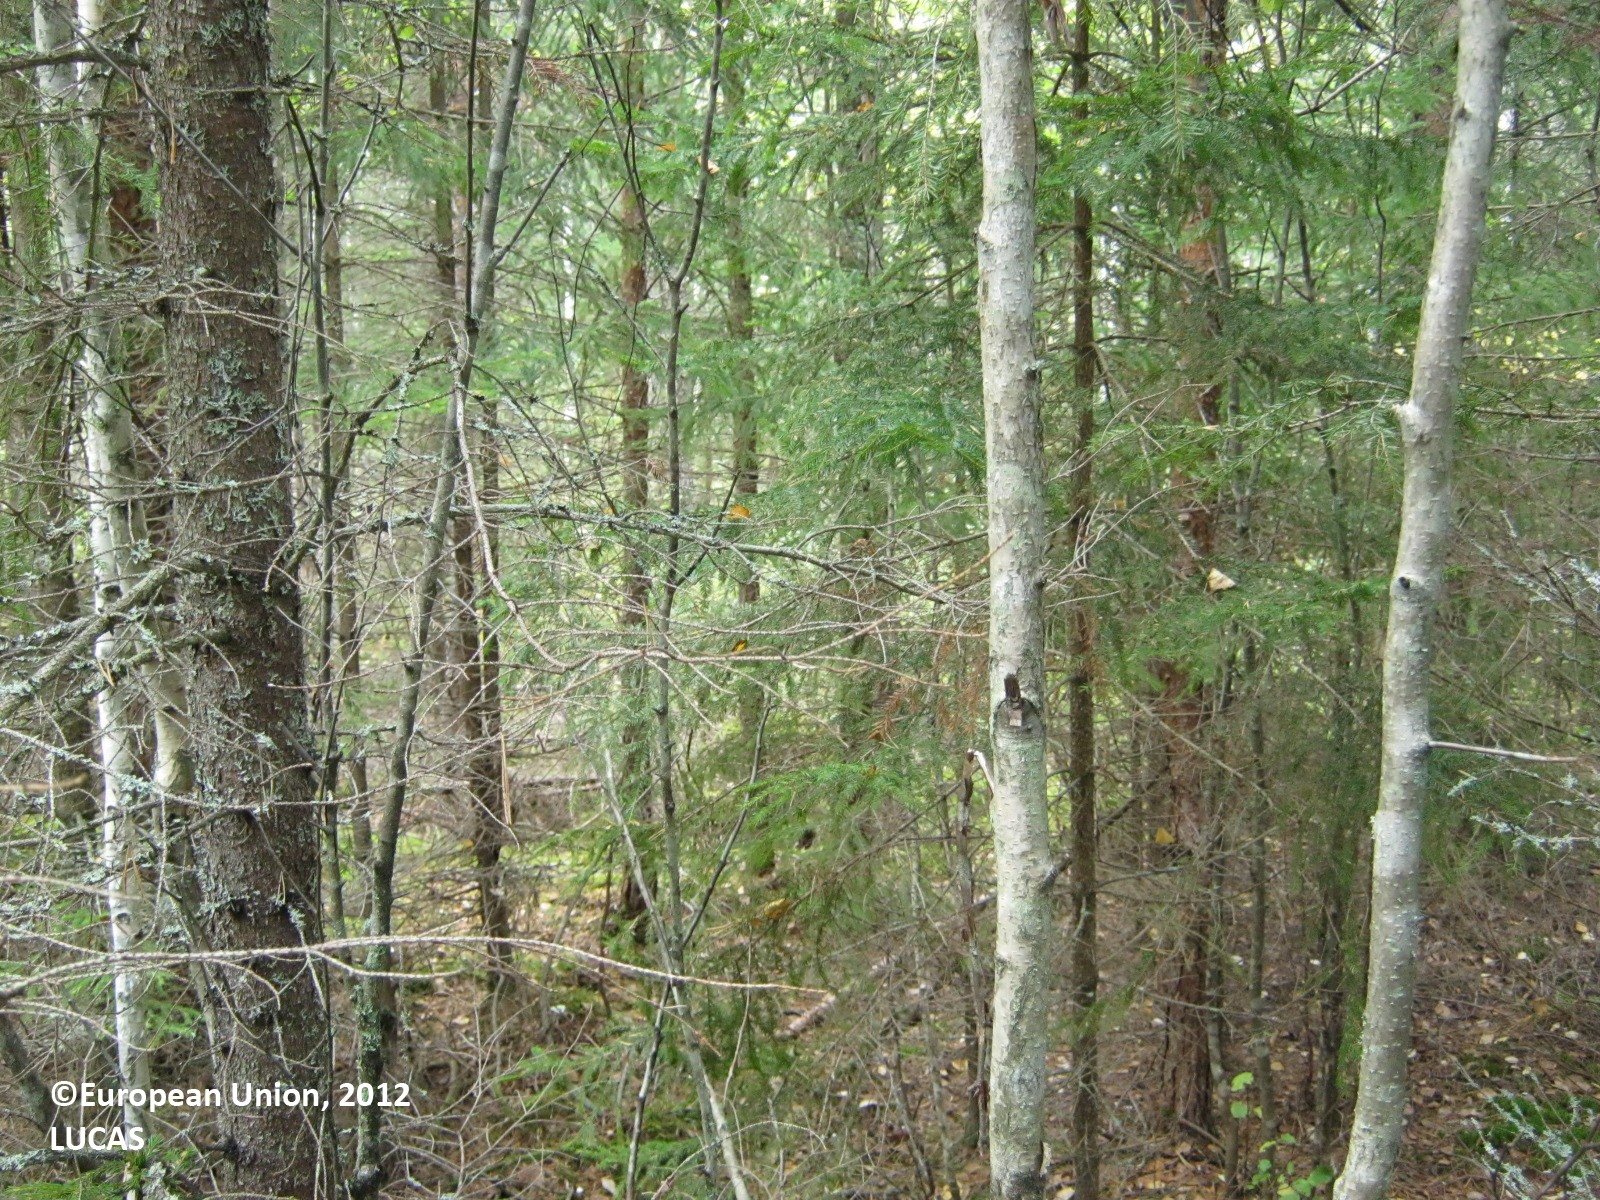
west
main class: Woodland
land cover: Other coniferous woodland
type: boreal forest
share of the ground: > 75 %
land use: Forestry
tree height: > 5 m
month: September
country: FI
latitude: 60.7108
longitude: 27.7290
